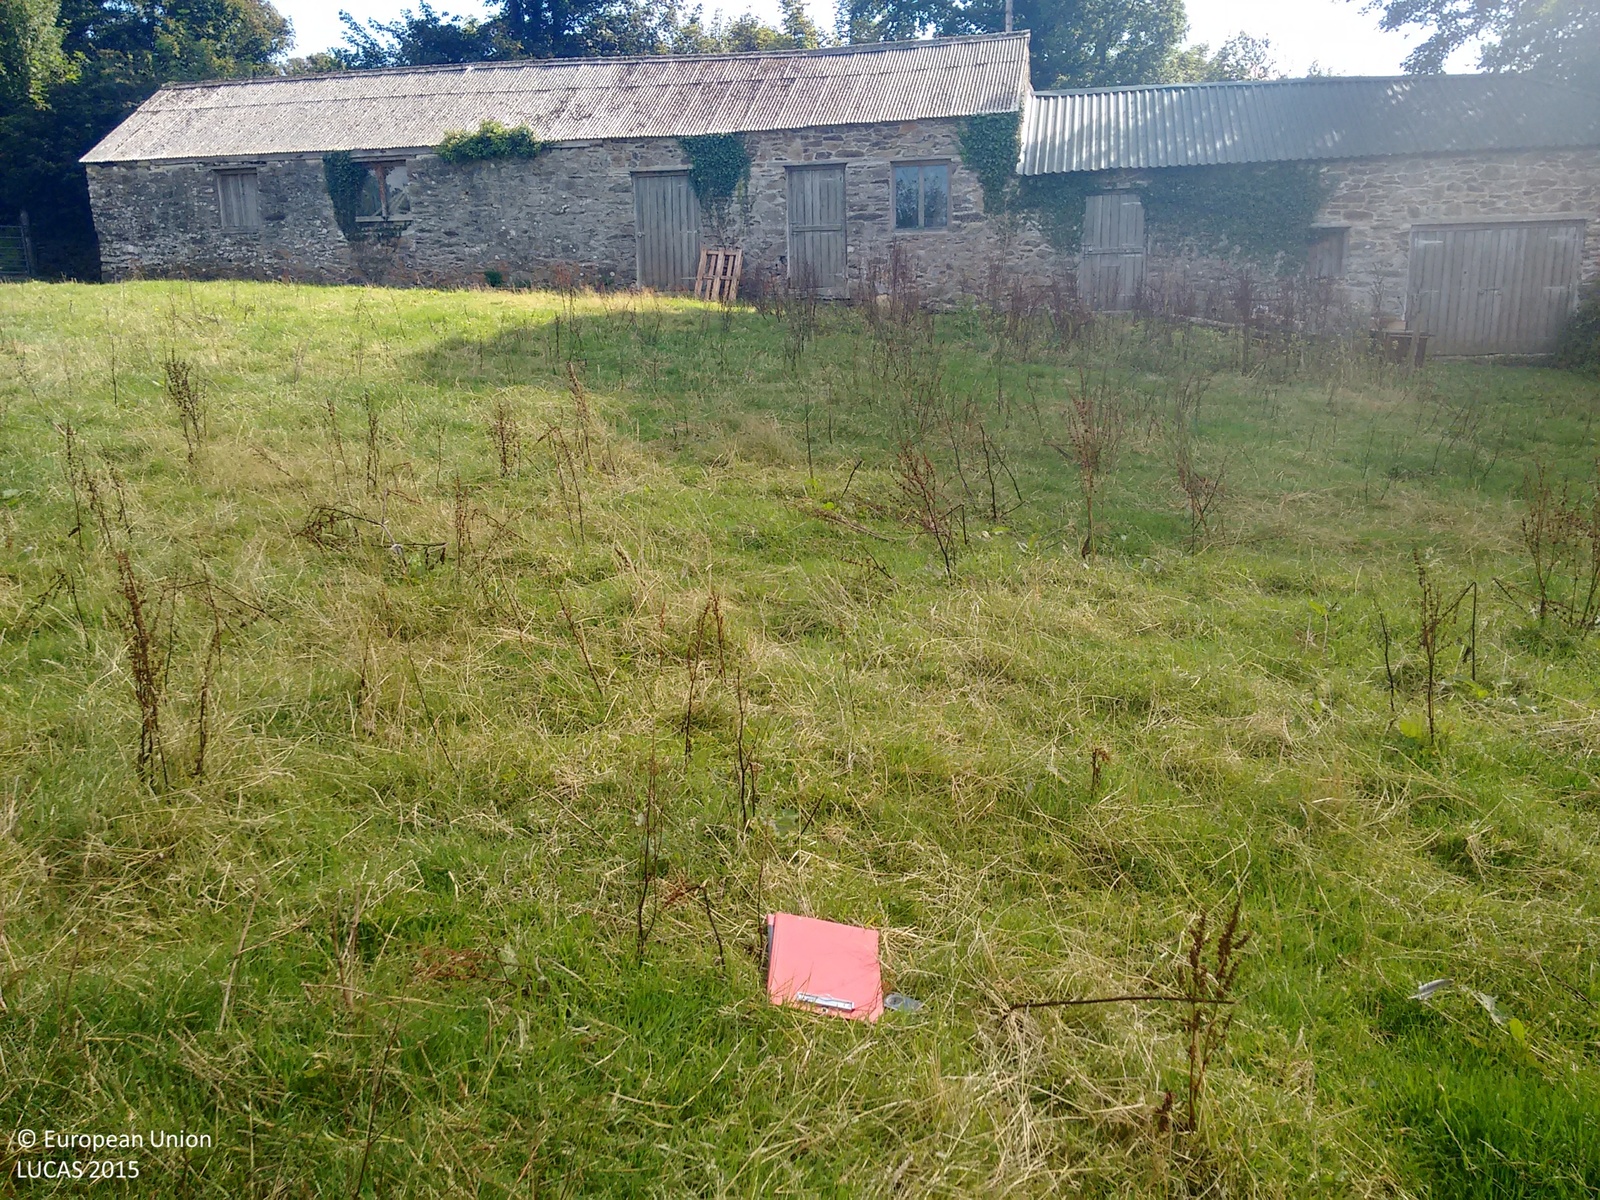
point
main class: Grassland
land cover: Grassland without tree/shrub cover
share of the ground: > 75 %
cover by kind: herbaceous plants 100 %
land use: Agriculture (excluding fallow land and kitchen gardens)
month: August
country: GB
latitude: 50.2961
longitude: -4.8949
